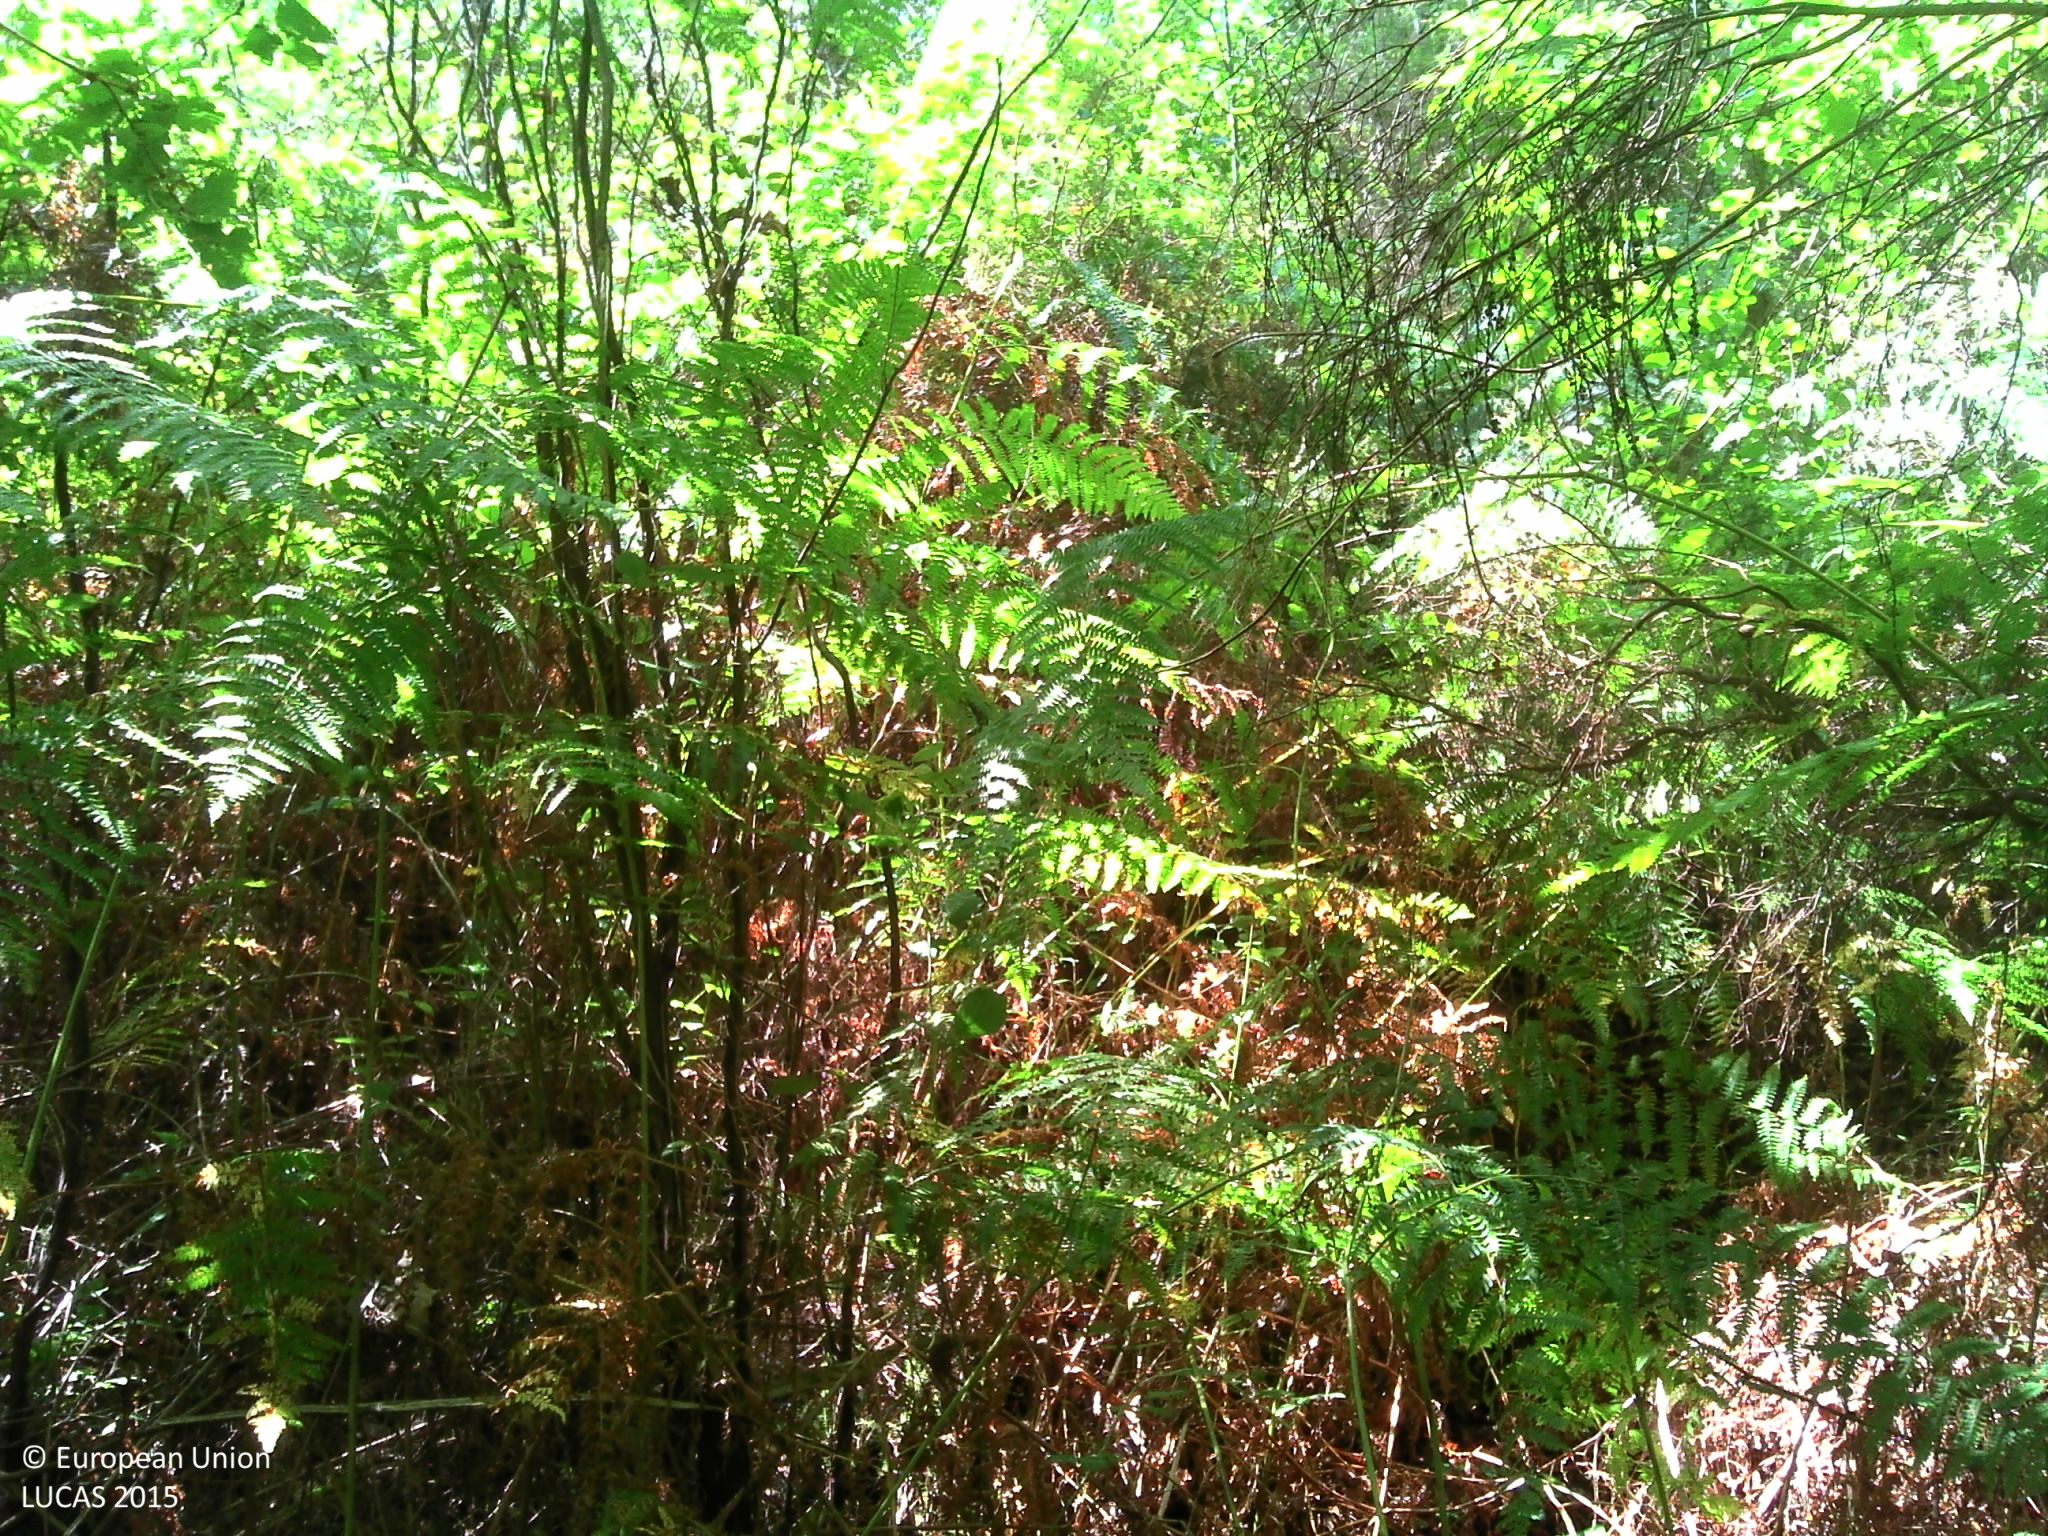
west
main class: Woodland
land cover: Broadleaved woodland
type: mesophytic deciduous forest
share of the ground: > 75 %
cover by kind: broadleaved forest trees 70 %, shrubs 10 %, herbaceous plants 10 %, coniferous forest trees 5 %, lichens and mosses 5 %
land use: Forestry
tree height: > 5 m
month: August
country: FR
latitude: 45.3345
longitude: 0.7640
